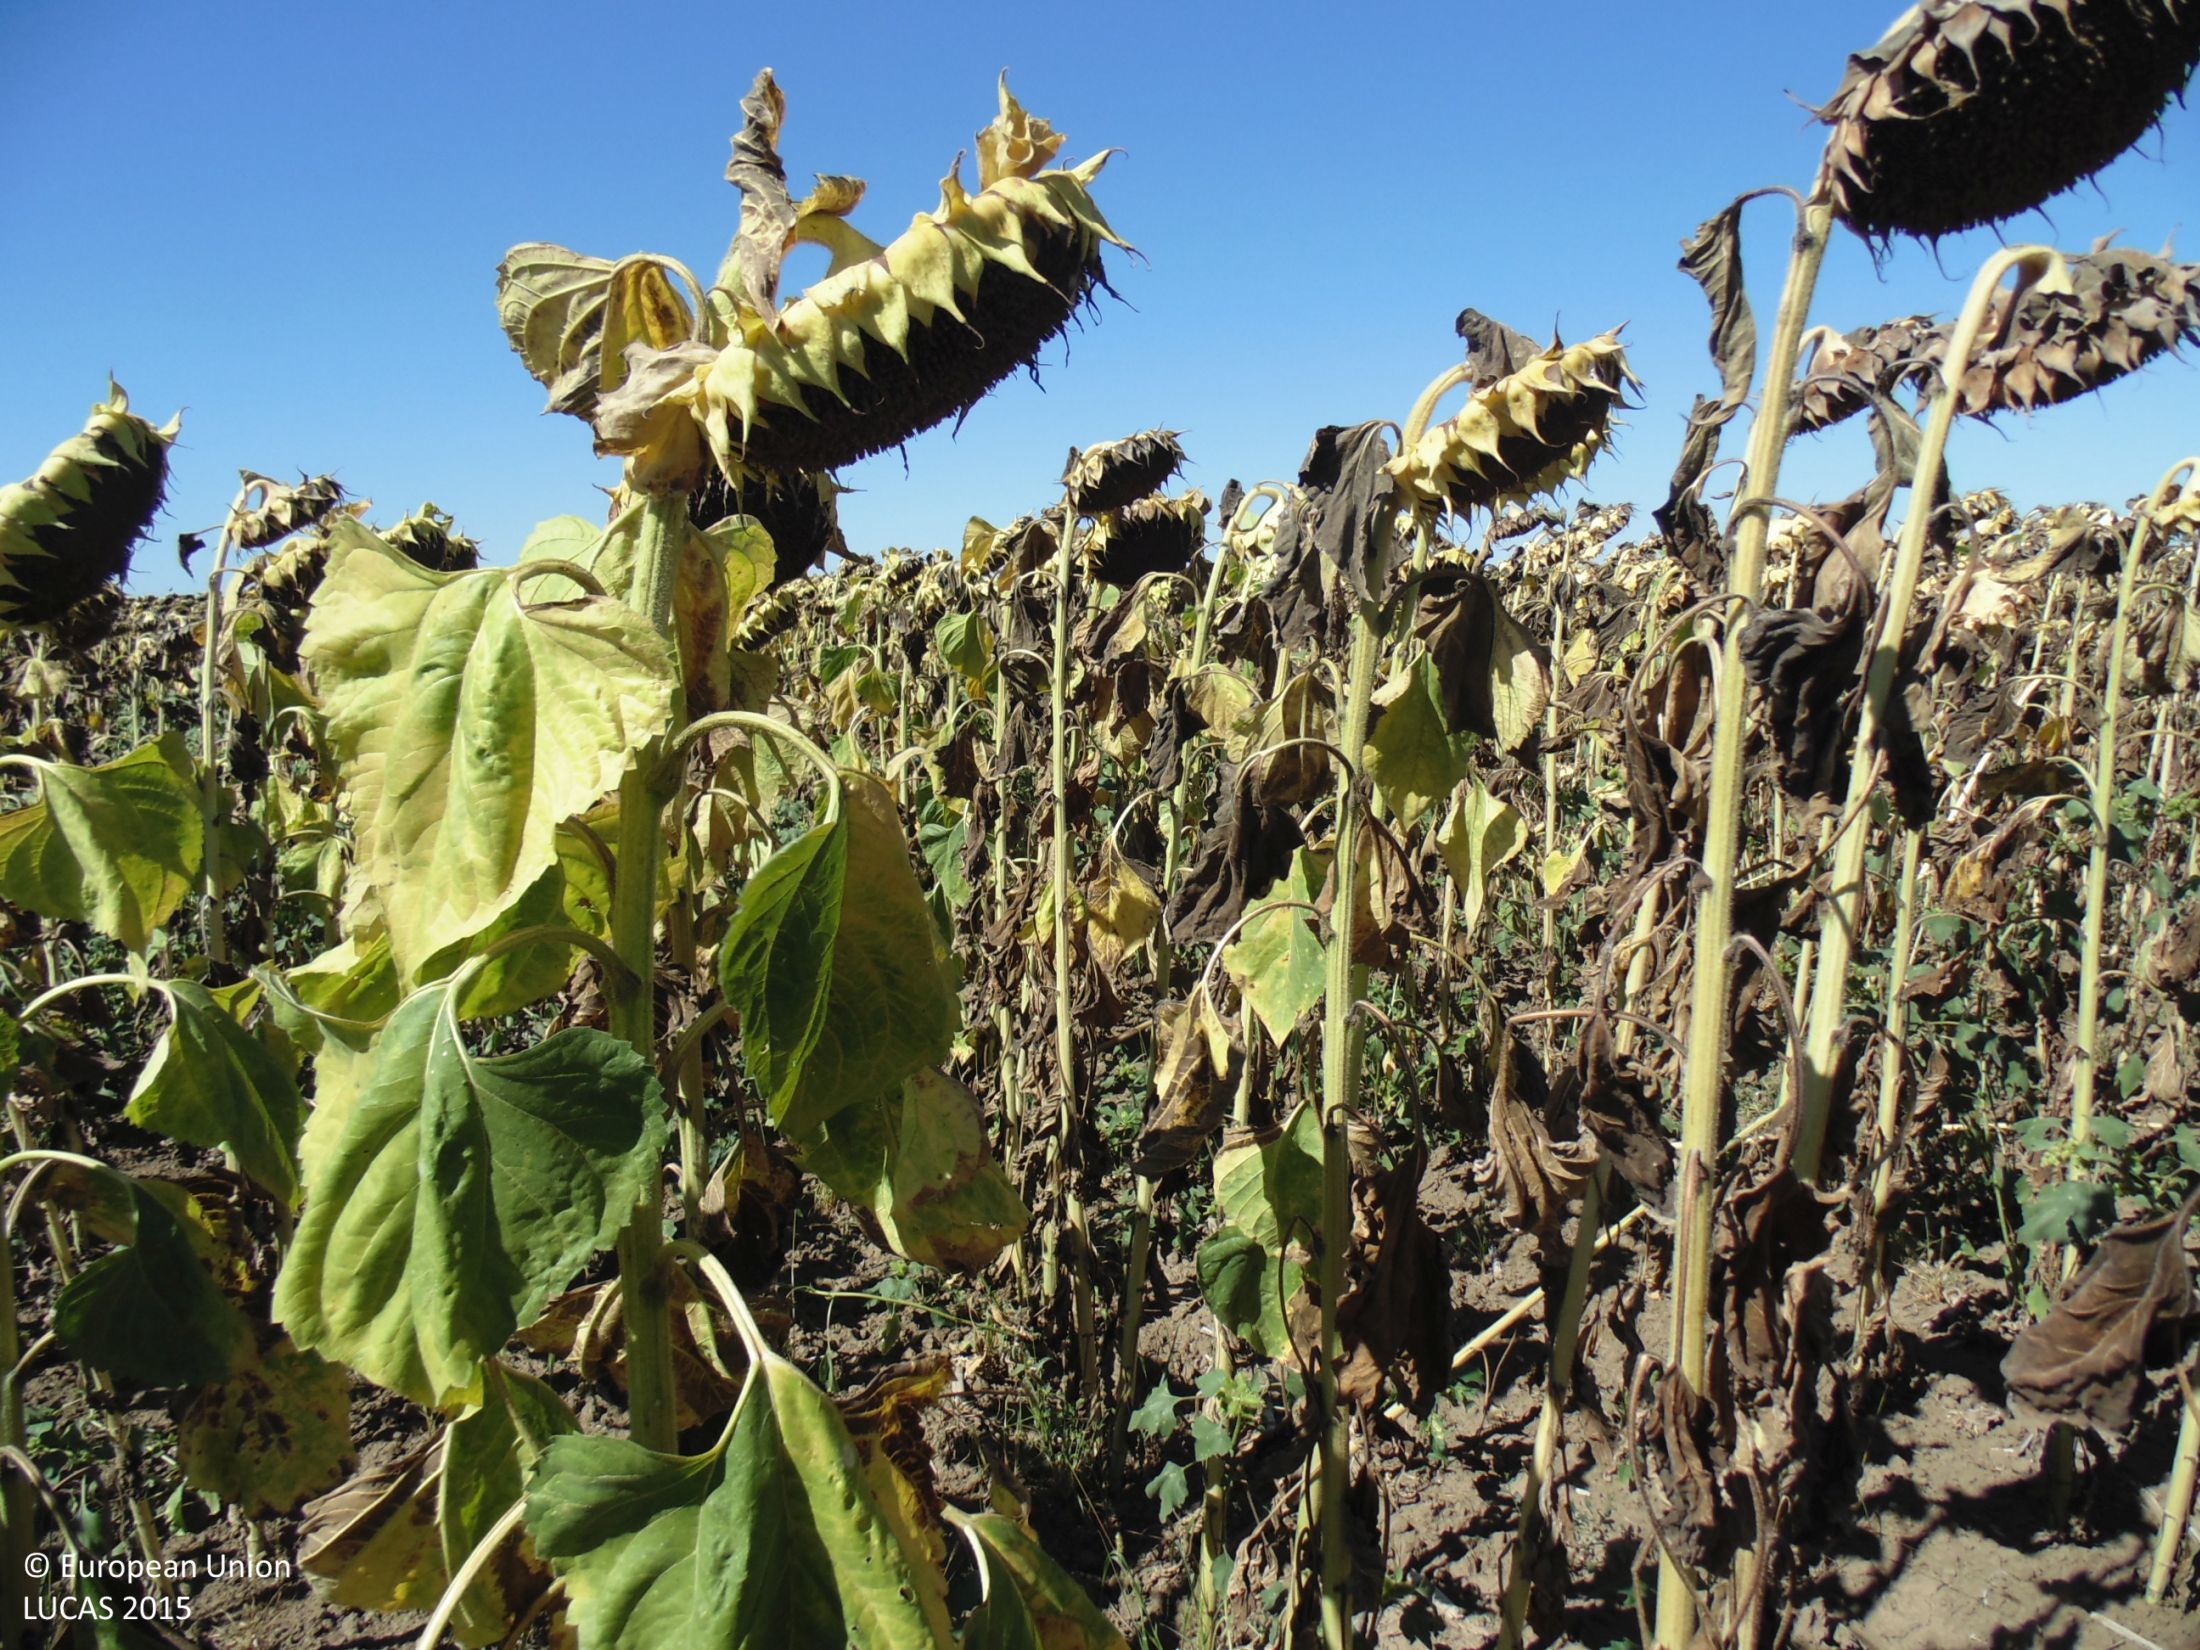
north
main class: Cropland
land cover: Sunflower
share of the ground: > 75 %
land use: Agriculture (excluding fallow land and kitchen gardens)
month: September
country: BG
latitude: 43.8837
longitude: 27.2682
